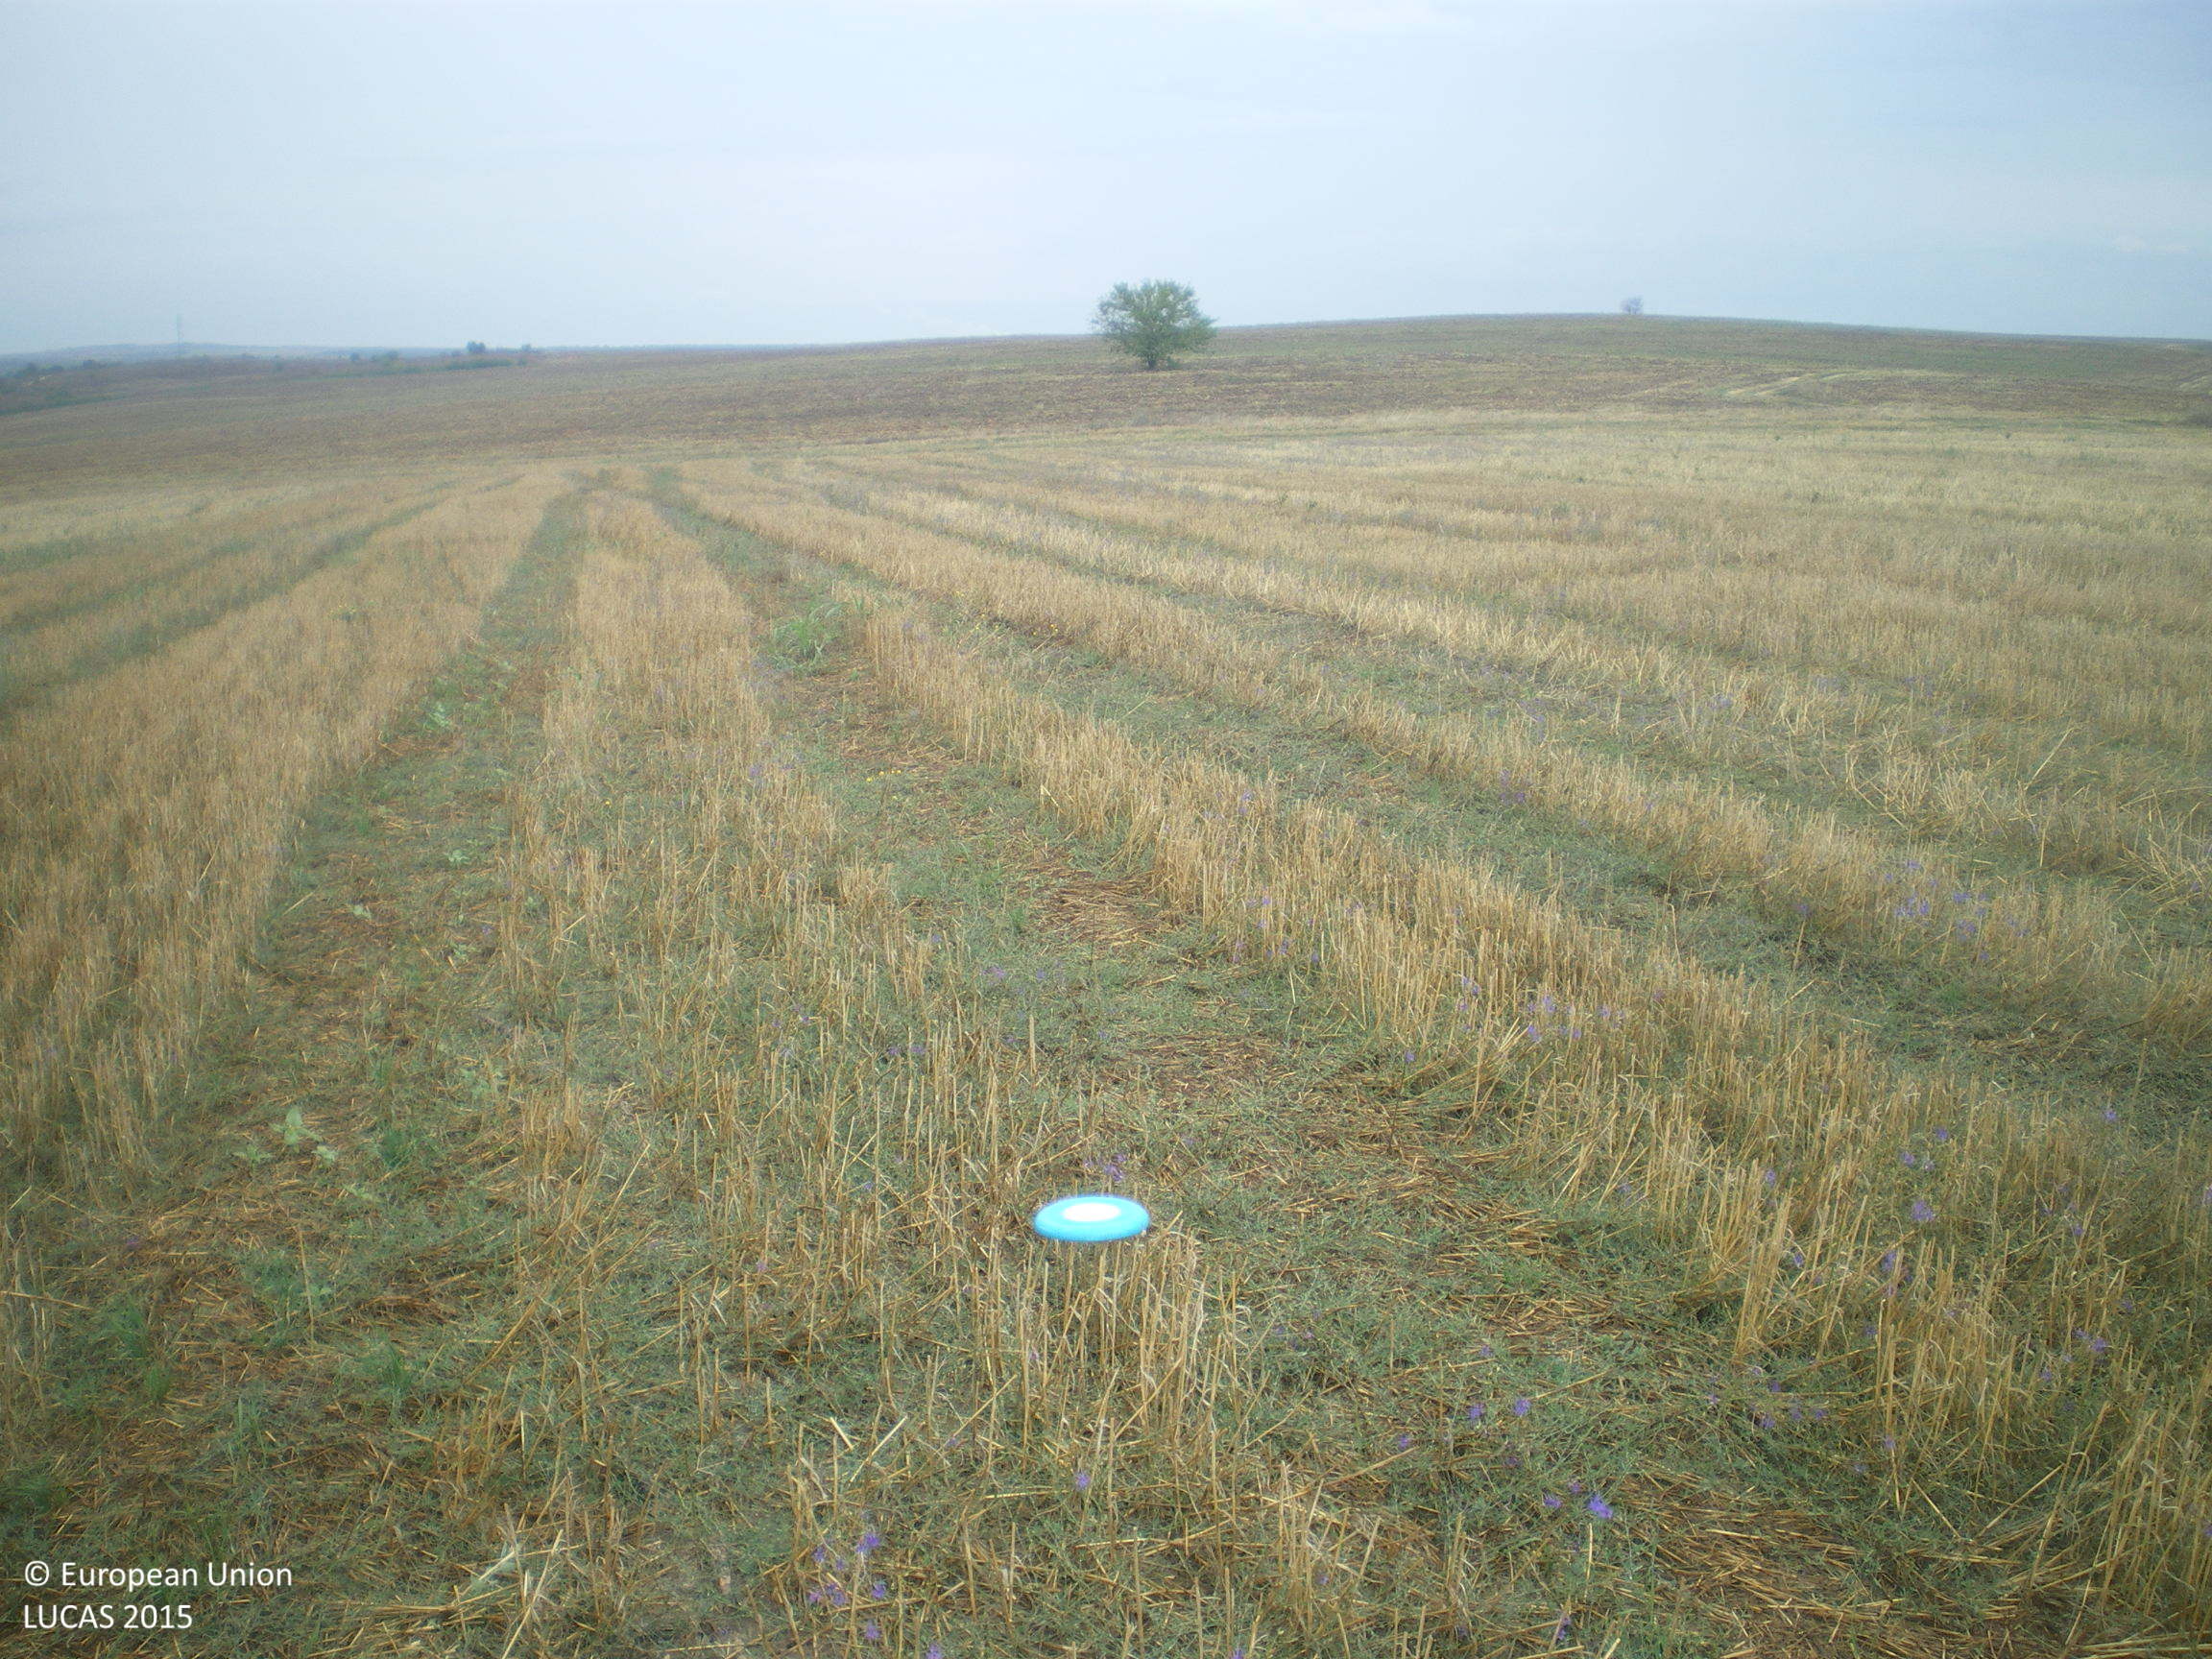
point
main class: Cropland
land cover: Common wheat
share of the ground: 25 - 50 %
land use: Agriculture (excluding fallow land and kitchen gardens)
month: September
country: BG
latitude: 41.9499
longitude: 25.8371
